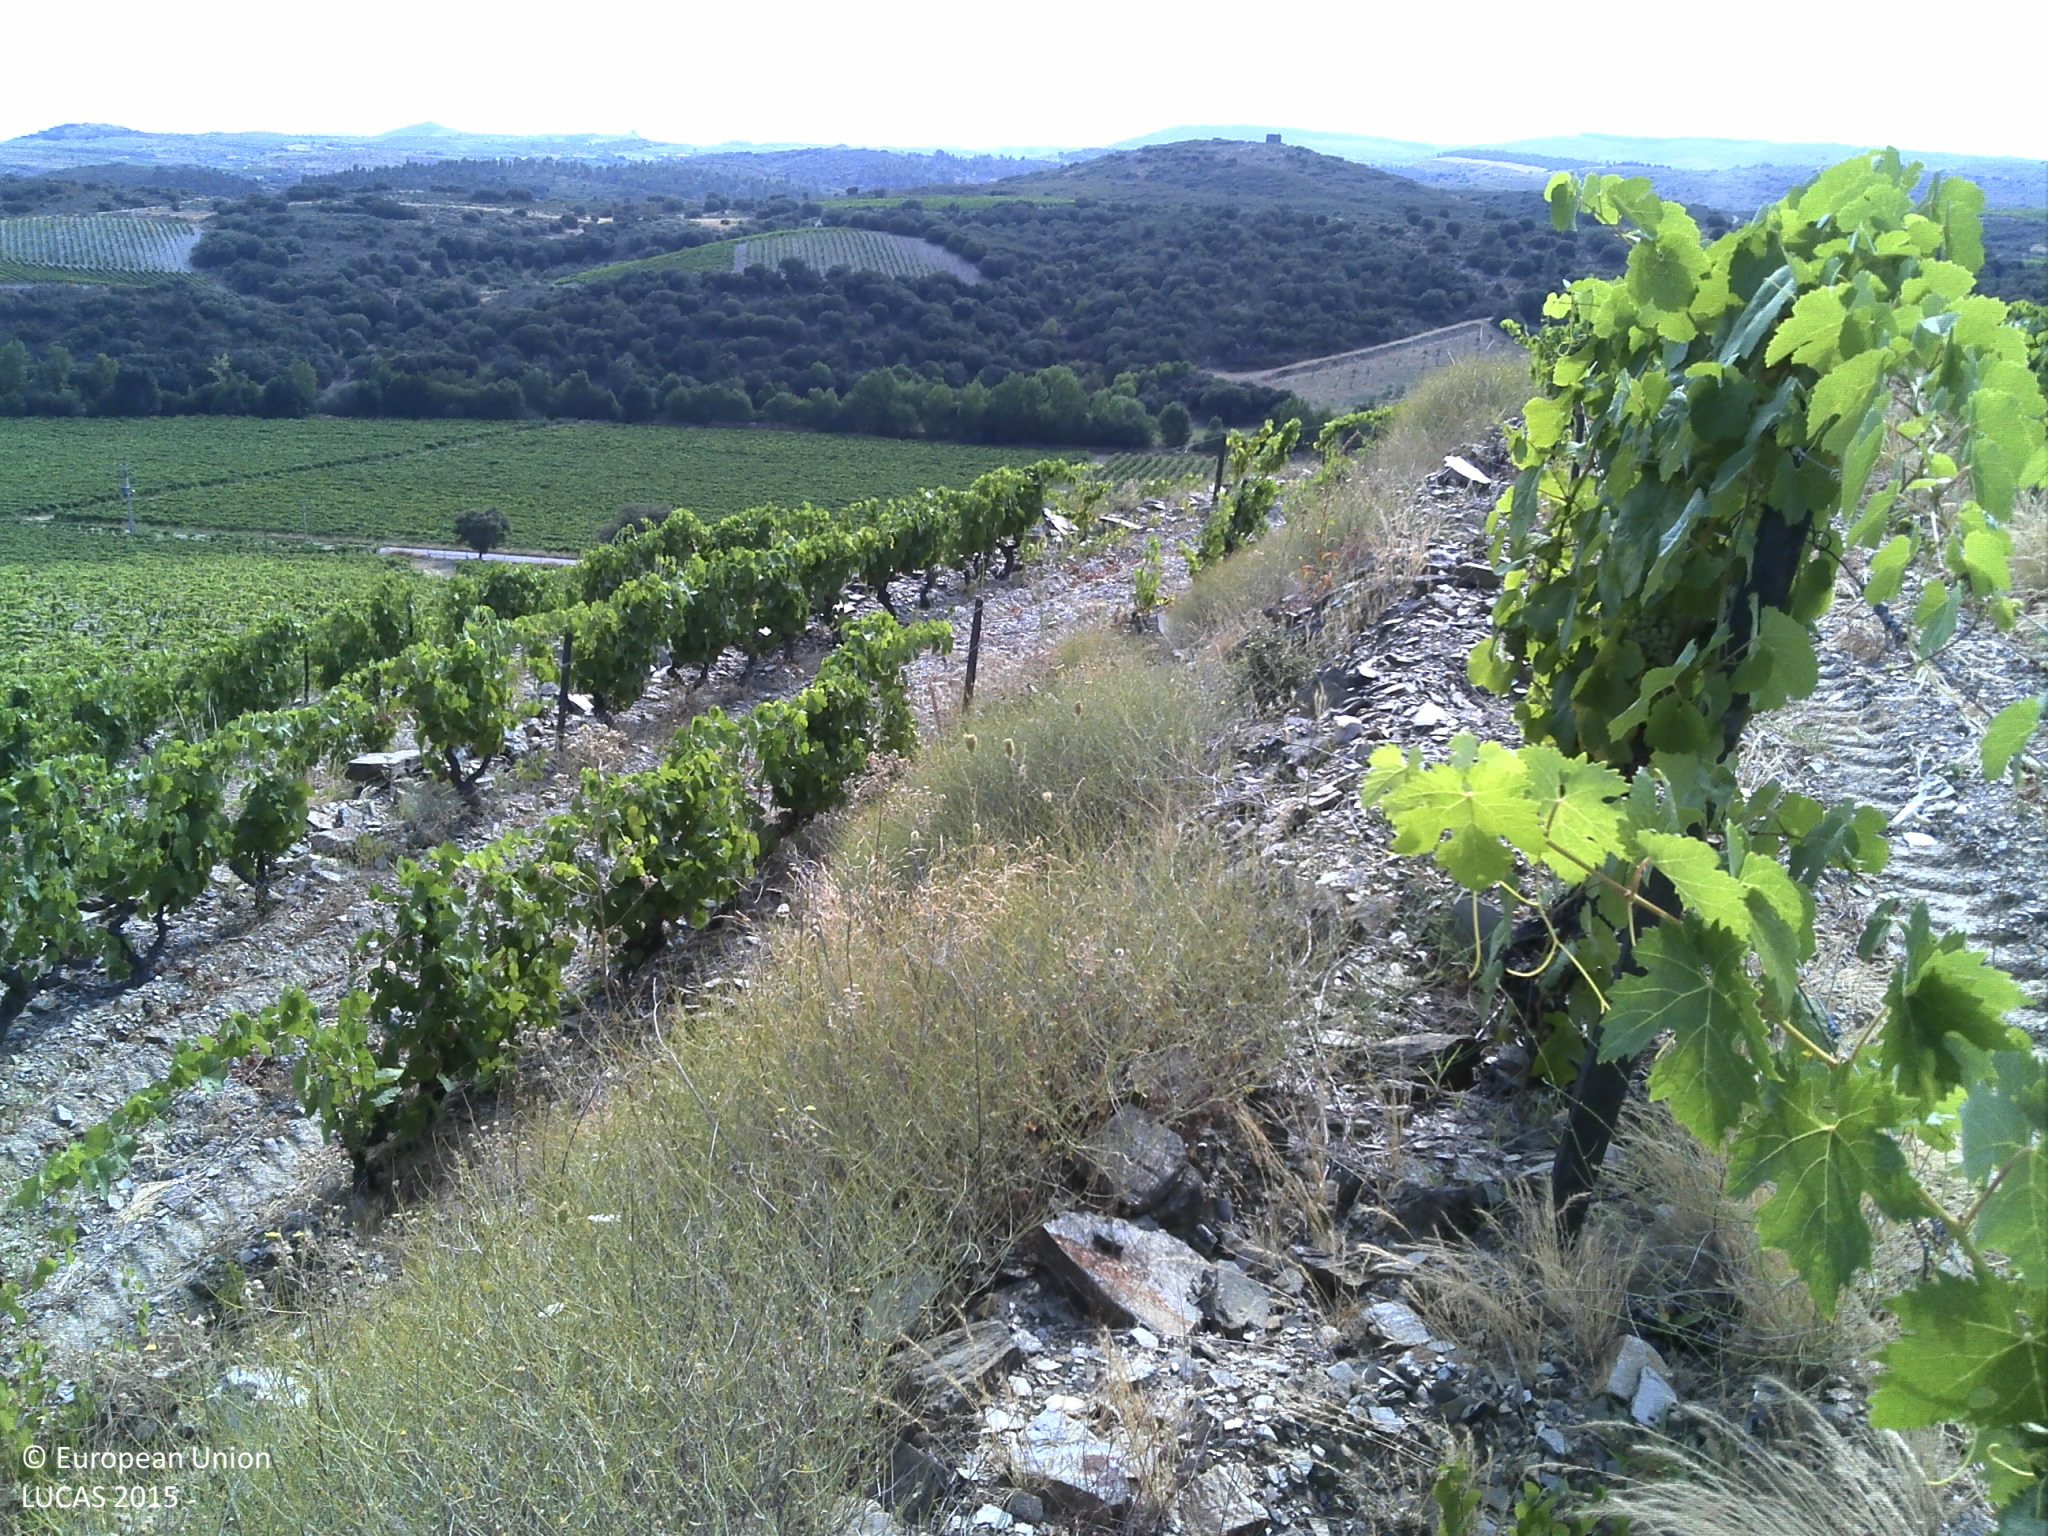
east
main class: Cropland
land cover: Vineyards
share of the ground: < 10 %
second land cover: Other bare soil
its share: > 75 %
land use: Agriculture (excluding fallow land and kitchen gardens)
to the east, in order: Vineyards; Other bare soil; Vineyards; Electric lines; Vineyards; Other fresh vegetables; Artificial constructions in urban areas; Apple fruit; Electric lines; Fences; Dry stone walls; Electric lines; Grass margins; Ditches and canals; Paved roads, cycling and walking lanes; Grass margins; Other bare soil; Vineyards
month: July
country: PT
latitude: 41.0406
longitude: -7.3044
